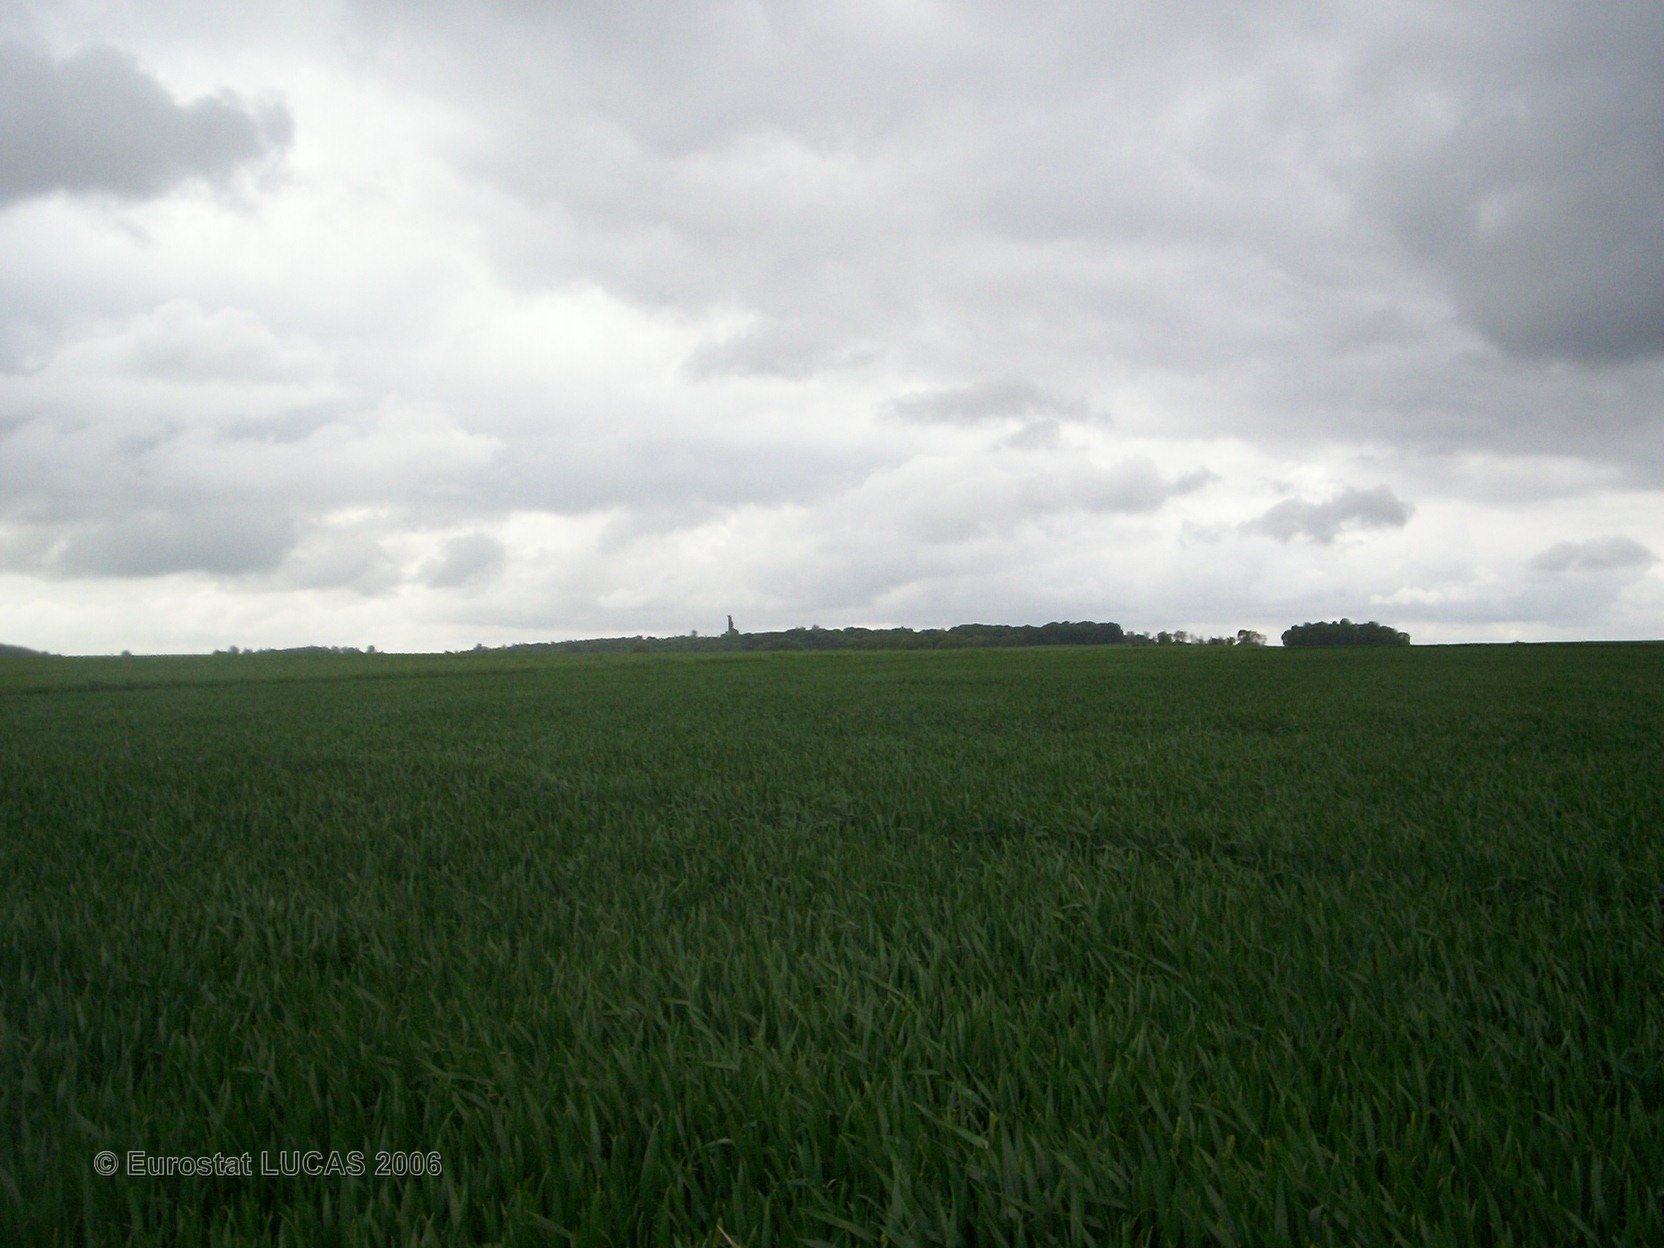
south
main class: Cropland
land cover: Common wheat
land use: Agriculture (excluding fallow land and kitchen gardens)
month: May
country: FR
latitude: 49.2276
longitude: 2.6978
